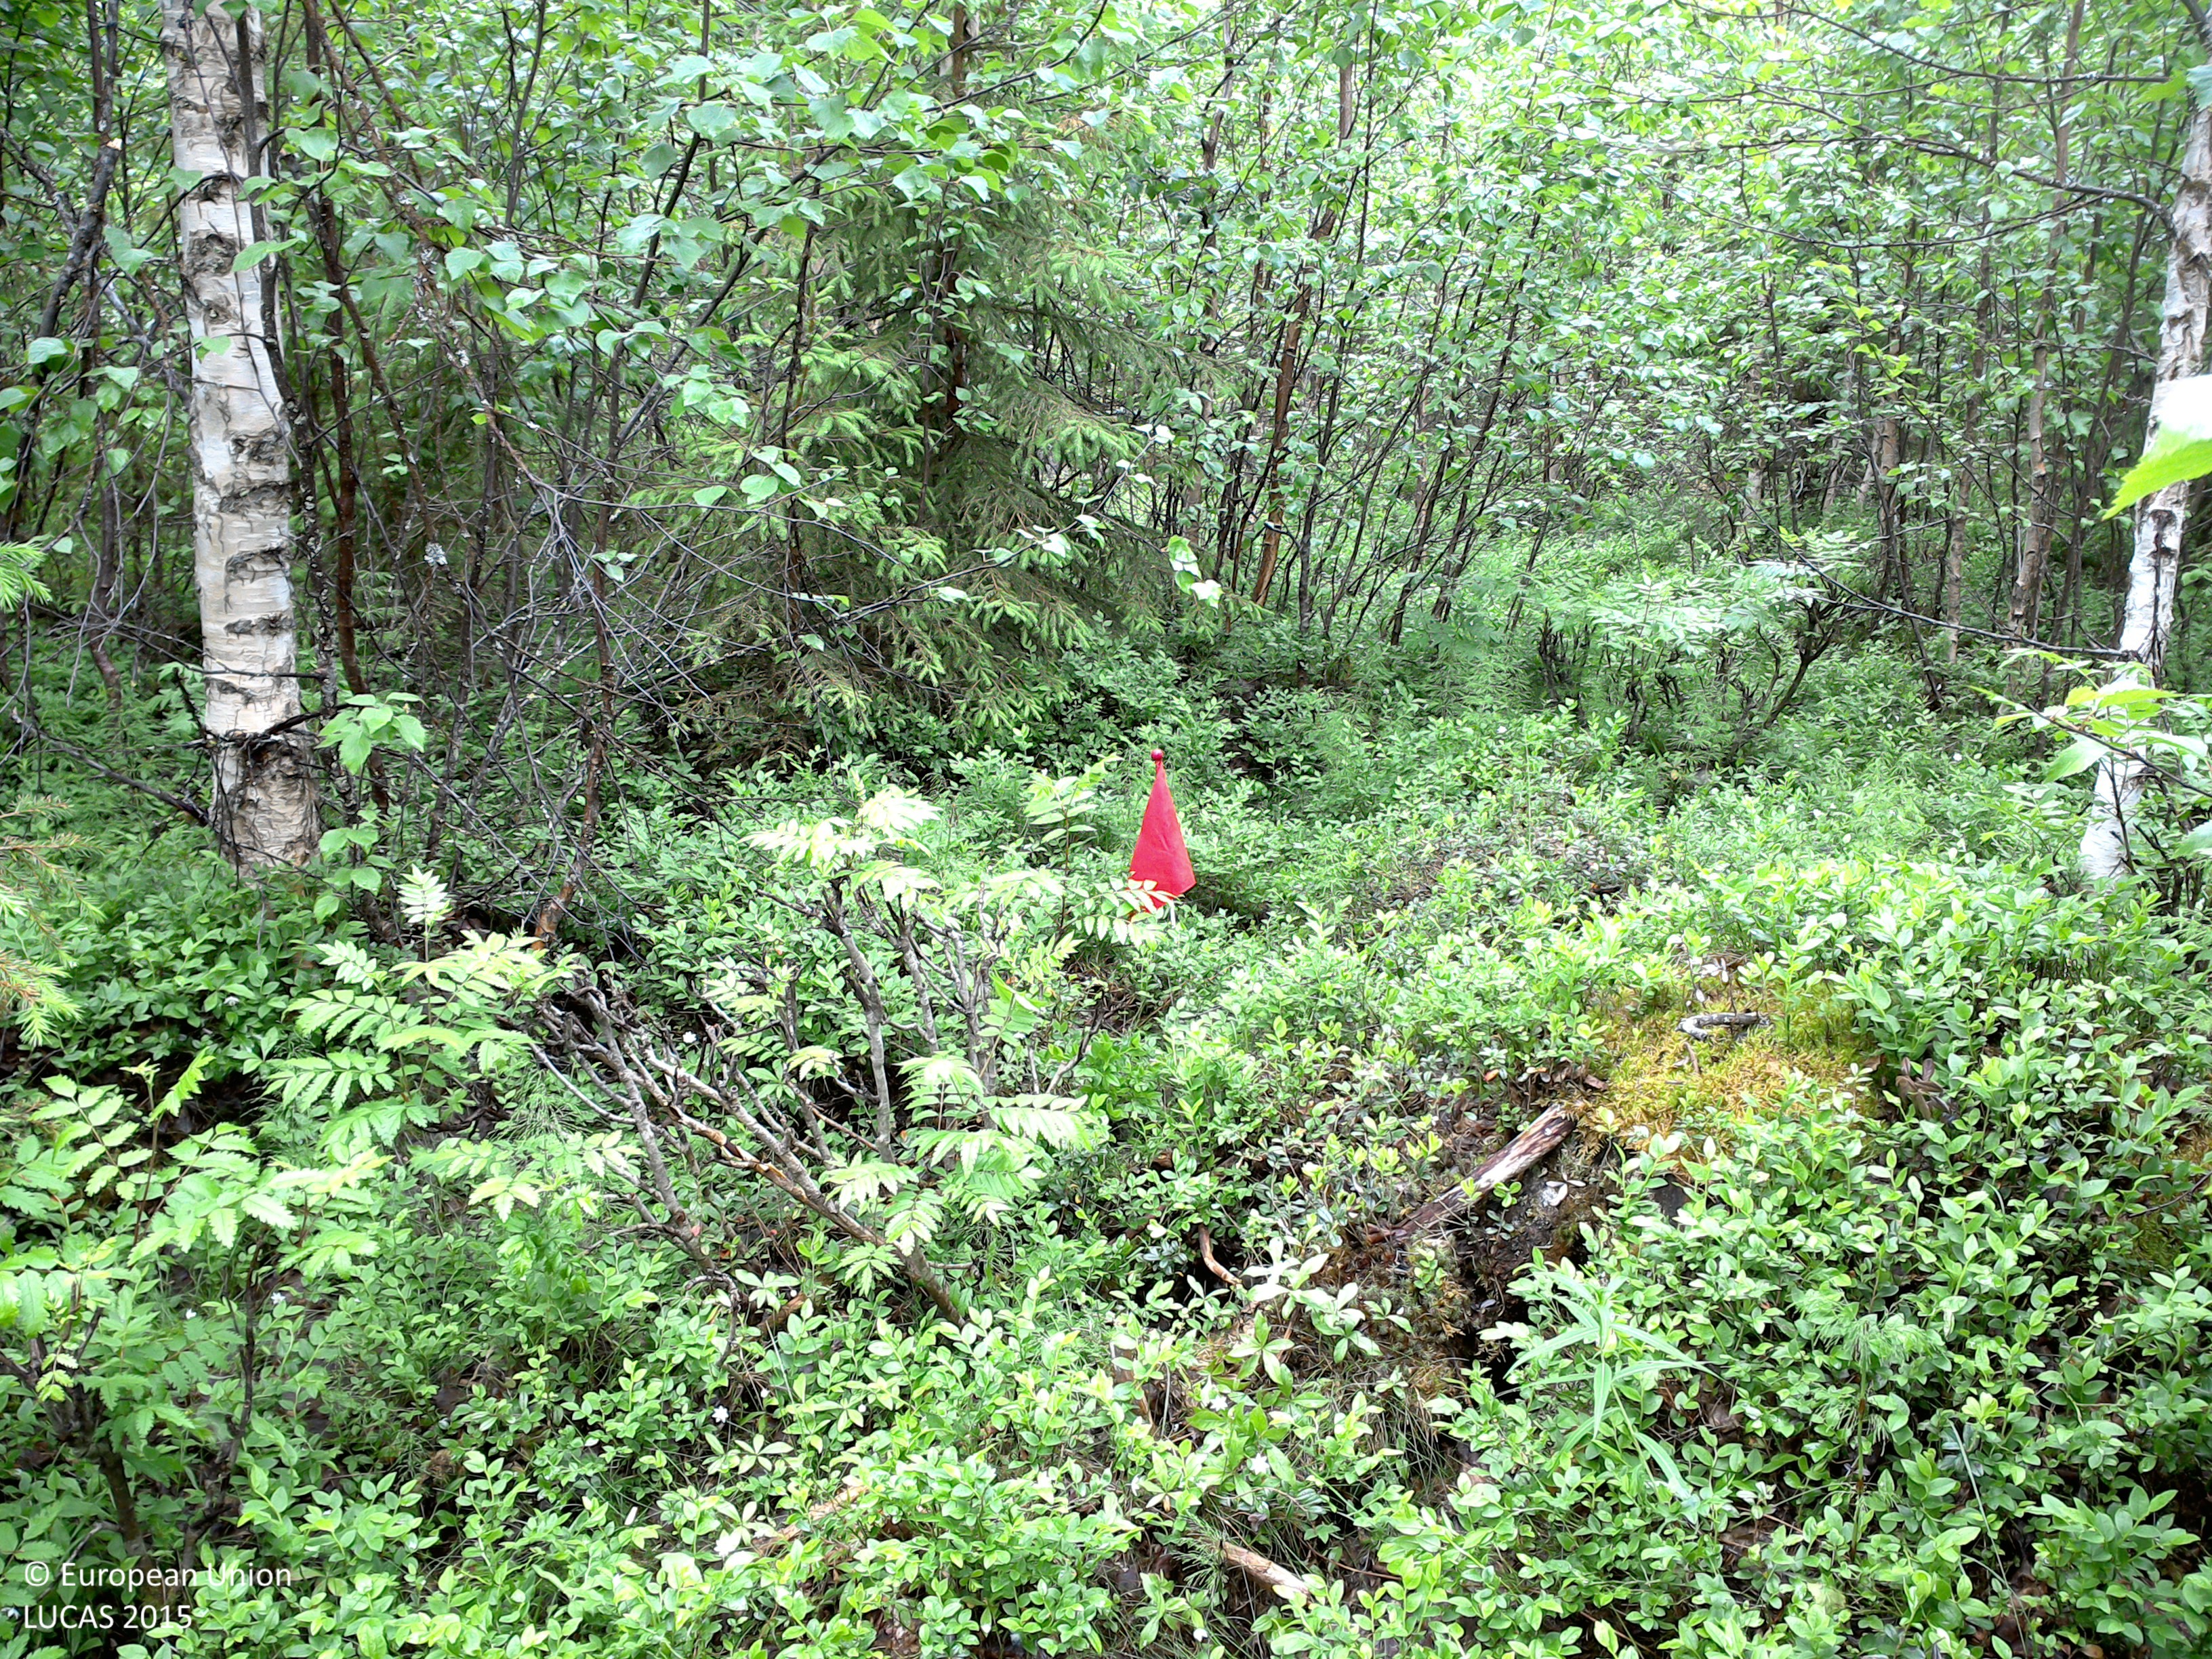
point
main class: Woodland
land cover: Broadleaved woodland
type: boreal forest
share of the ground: 50 - 75 %
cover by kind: broadleaved forest trees 50 %, shrubs 45 %, coniferous forest trees 5 %
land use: Forestry
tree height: > 5 m
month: July
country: SE
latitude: 66.5901
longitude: 23.3561
